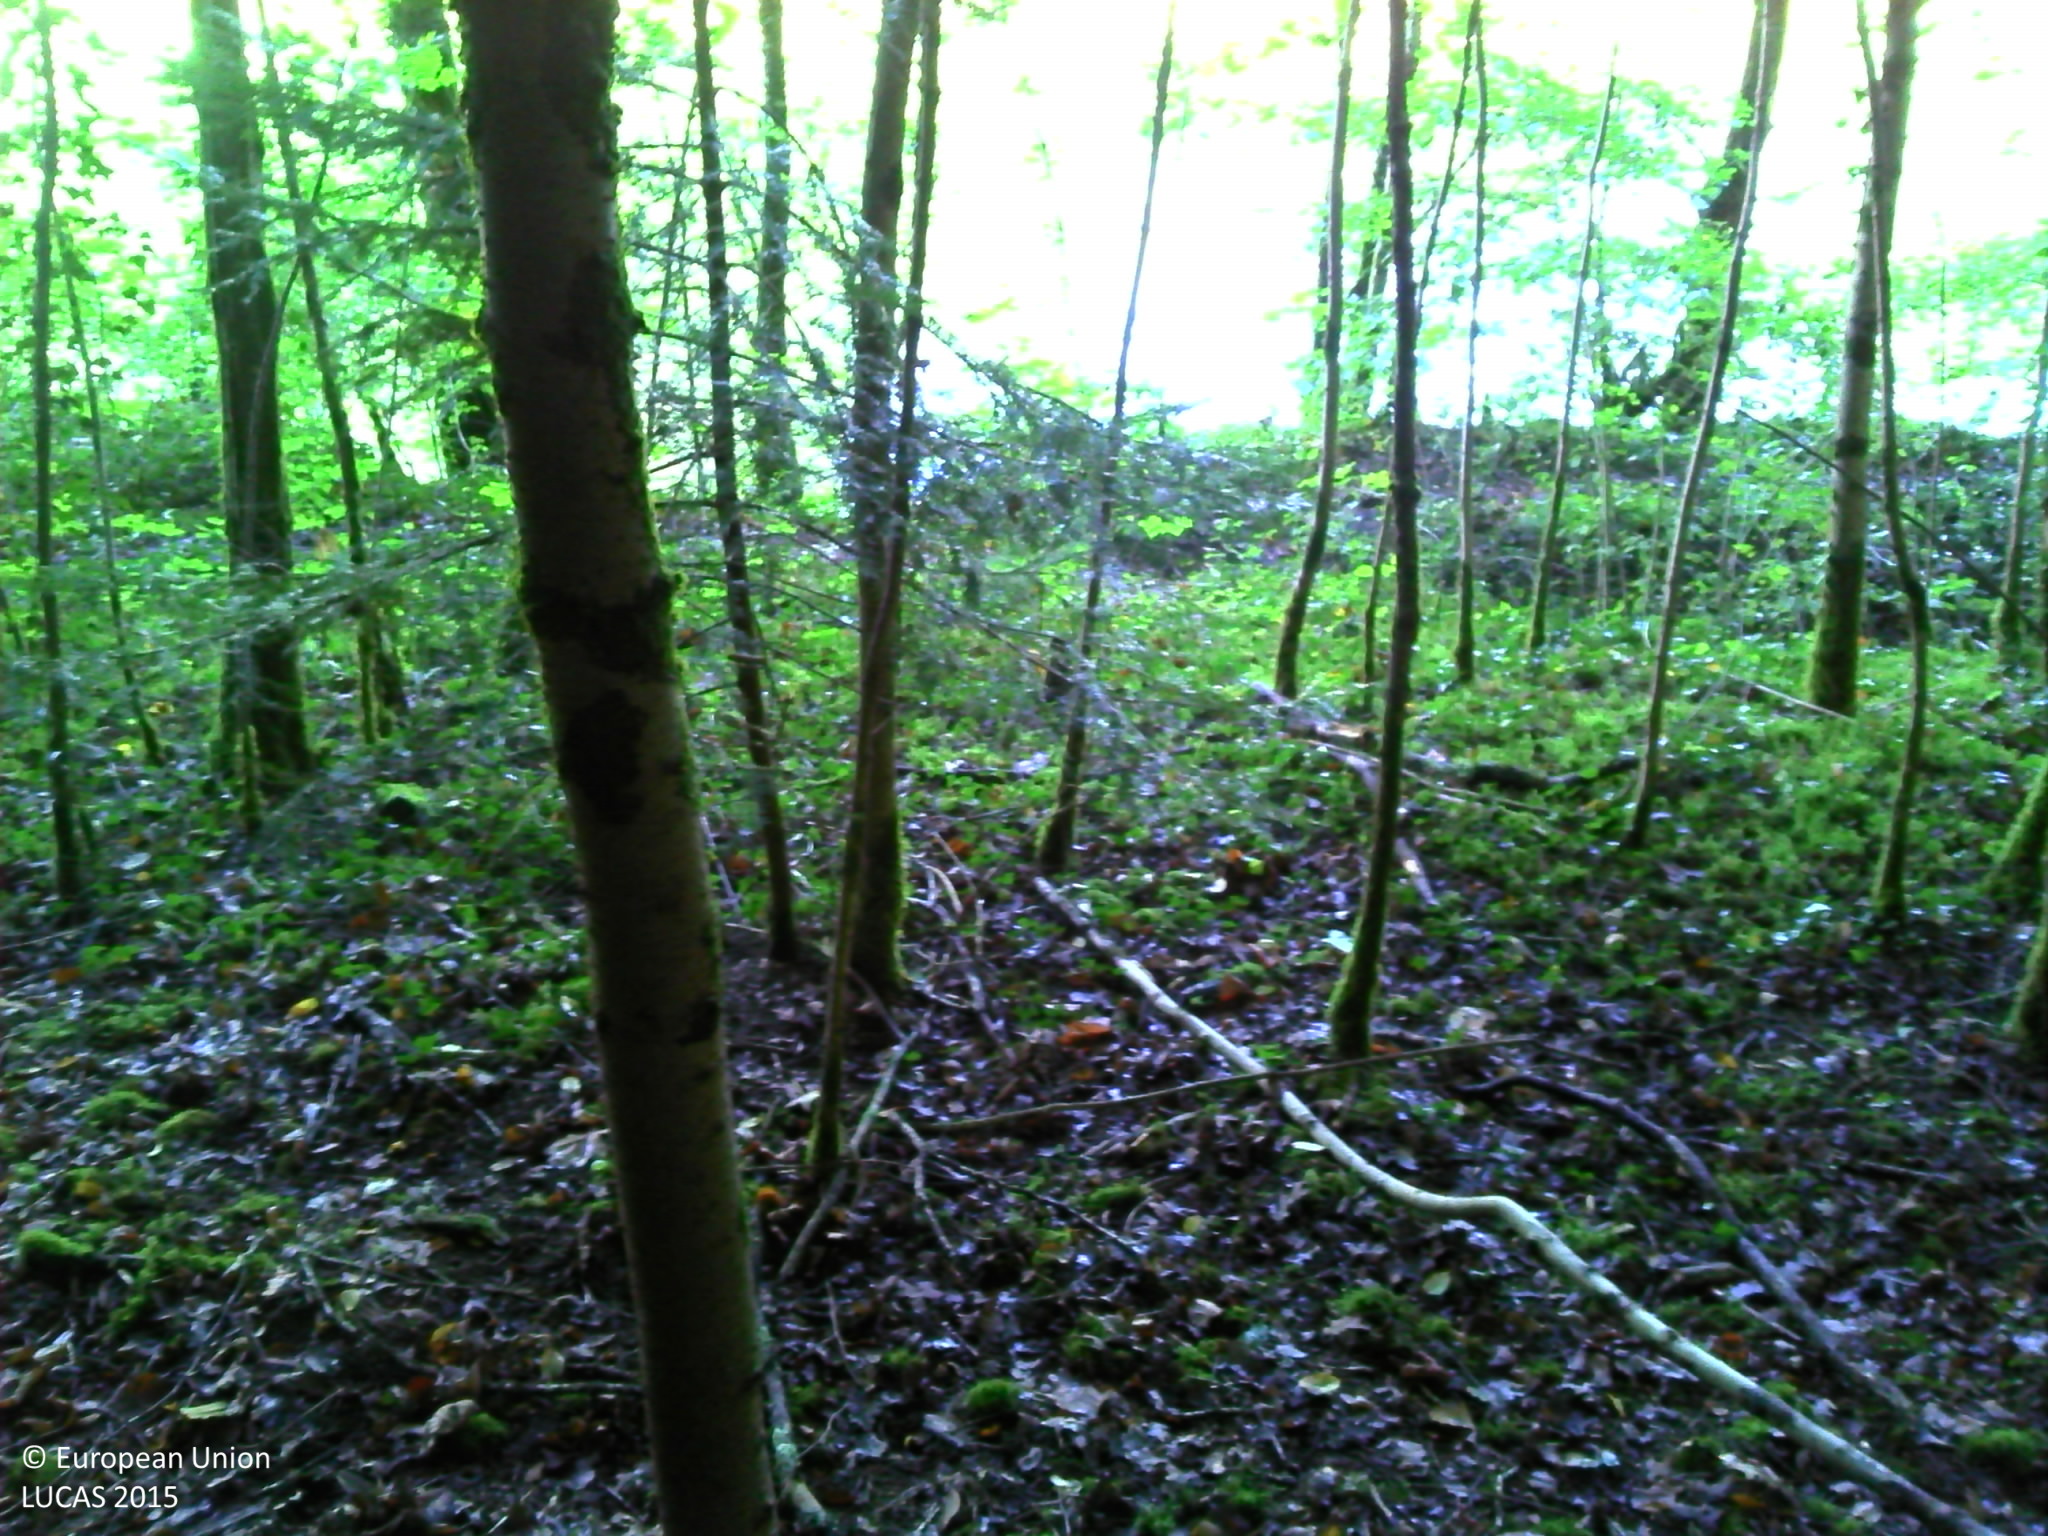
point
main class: Woodland
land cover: Broadleaved woodland
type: floodplain forest
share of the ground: > 75 %
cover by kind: broadleaved forest trees 90 %, herbaceous plants 5 %, unconsolidated bare surface 5 %
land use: Forestry
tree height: > 5 m
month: September
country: FR
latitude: 47.1099
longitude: 6.1144
